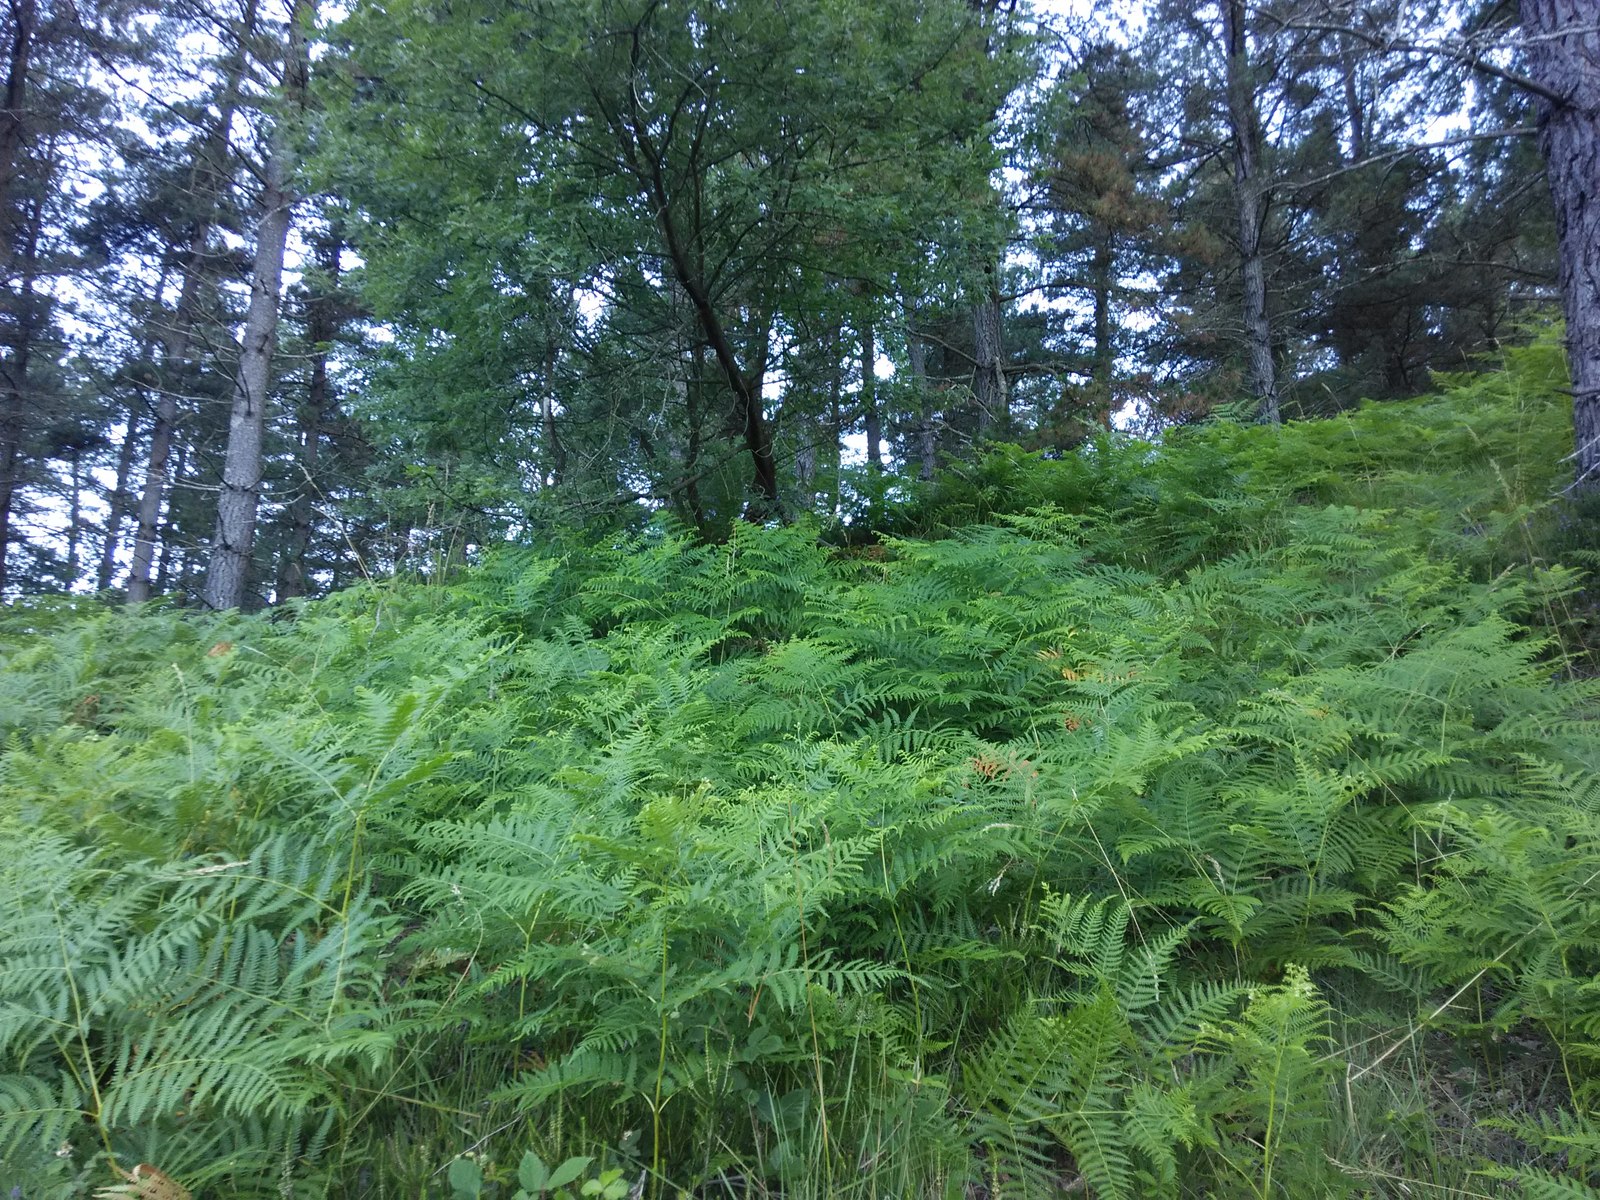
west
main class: Woodland
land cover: Pine dominated coniferous woodland
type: exotic forest
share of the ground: > 75 %
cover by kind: coniferous forest trees 100 %
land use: Forestry
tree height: < 5 m
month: July
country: ES
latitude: 43.2146
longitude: -2.5973
